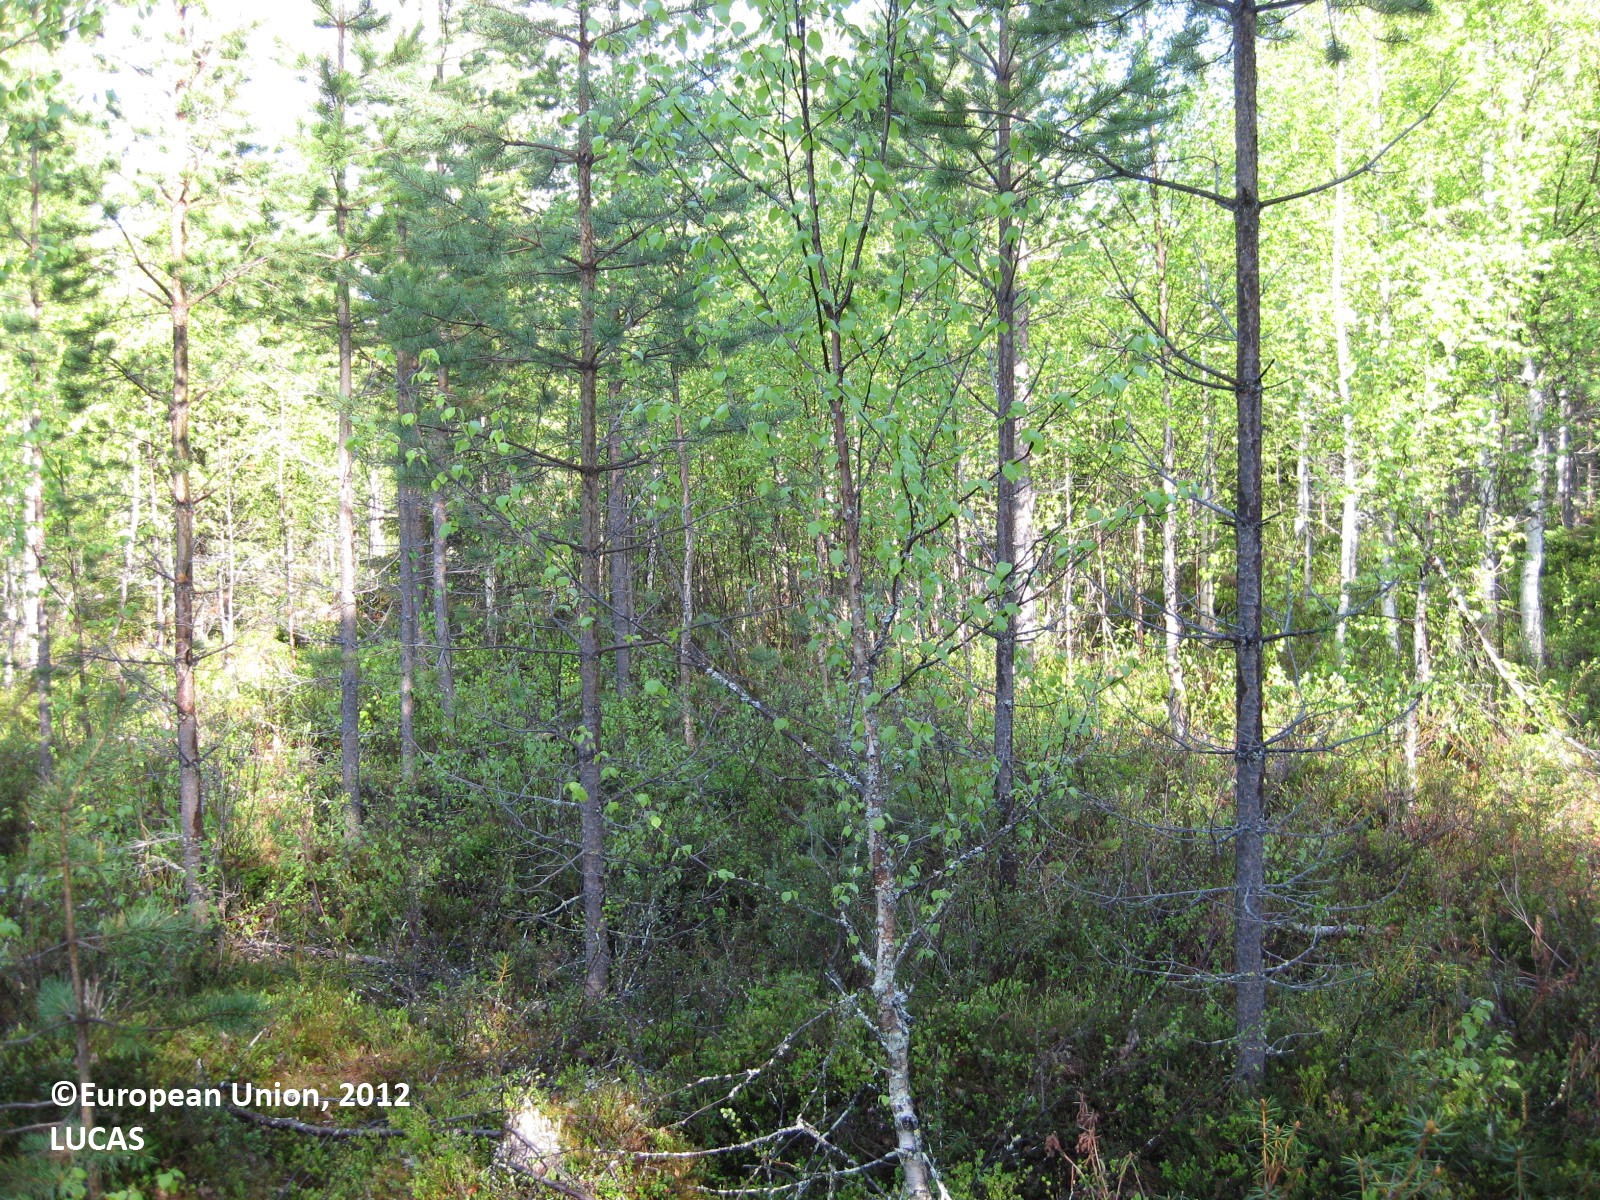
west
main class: Woodland
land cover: Pine dominated mixed woodland
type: boreal forest
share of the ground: 50 - 75 %
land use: Forestry
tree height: > 5 m
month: June
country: FI
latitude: 65.1278
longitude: 29.5766
